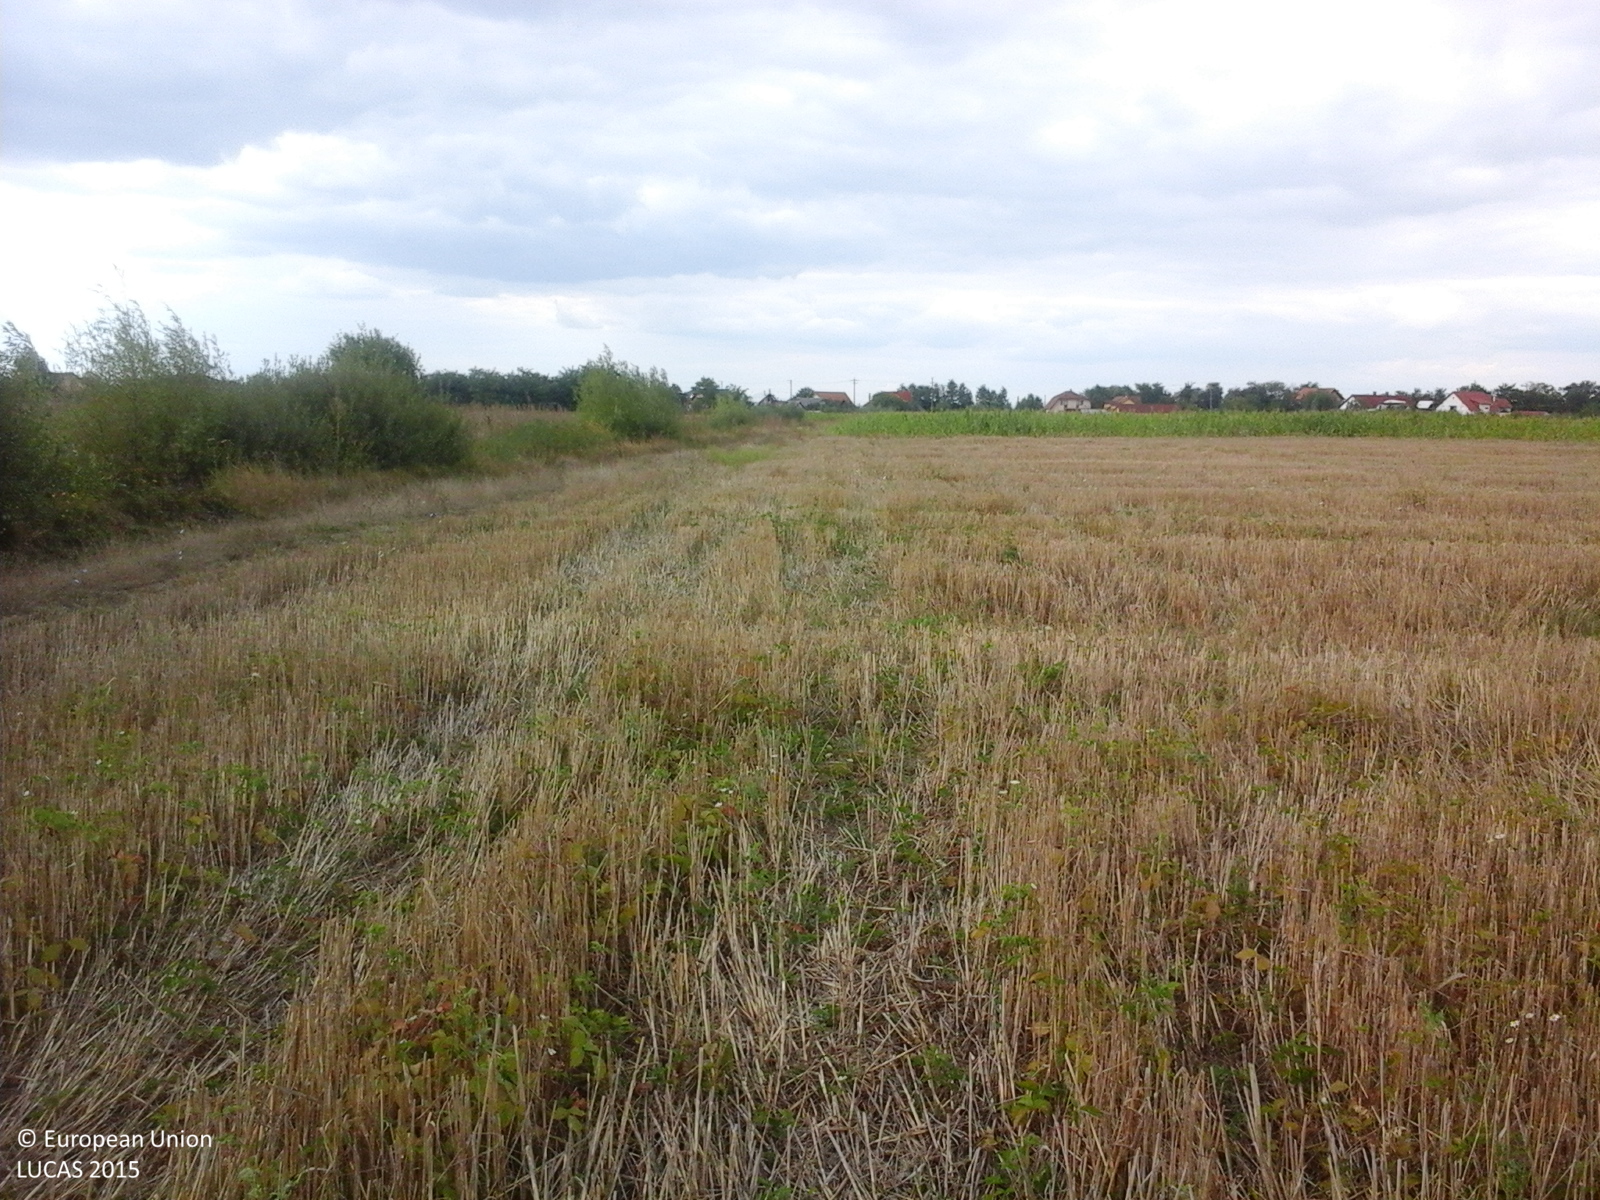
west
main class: Cropland
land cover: Durum wheat
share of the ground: > 75 %
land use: Agriculture (excluding fallow land and kitchen gardens)
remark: Harvested field
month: September
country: RO
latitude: 47.7521
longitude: 22.9104
